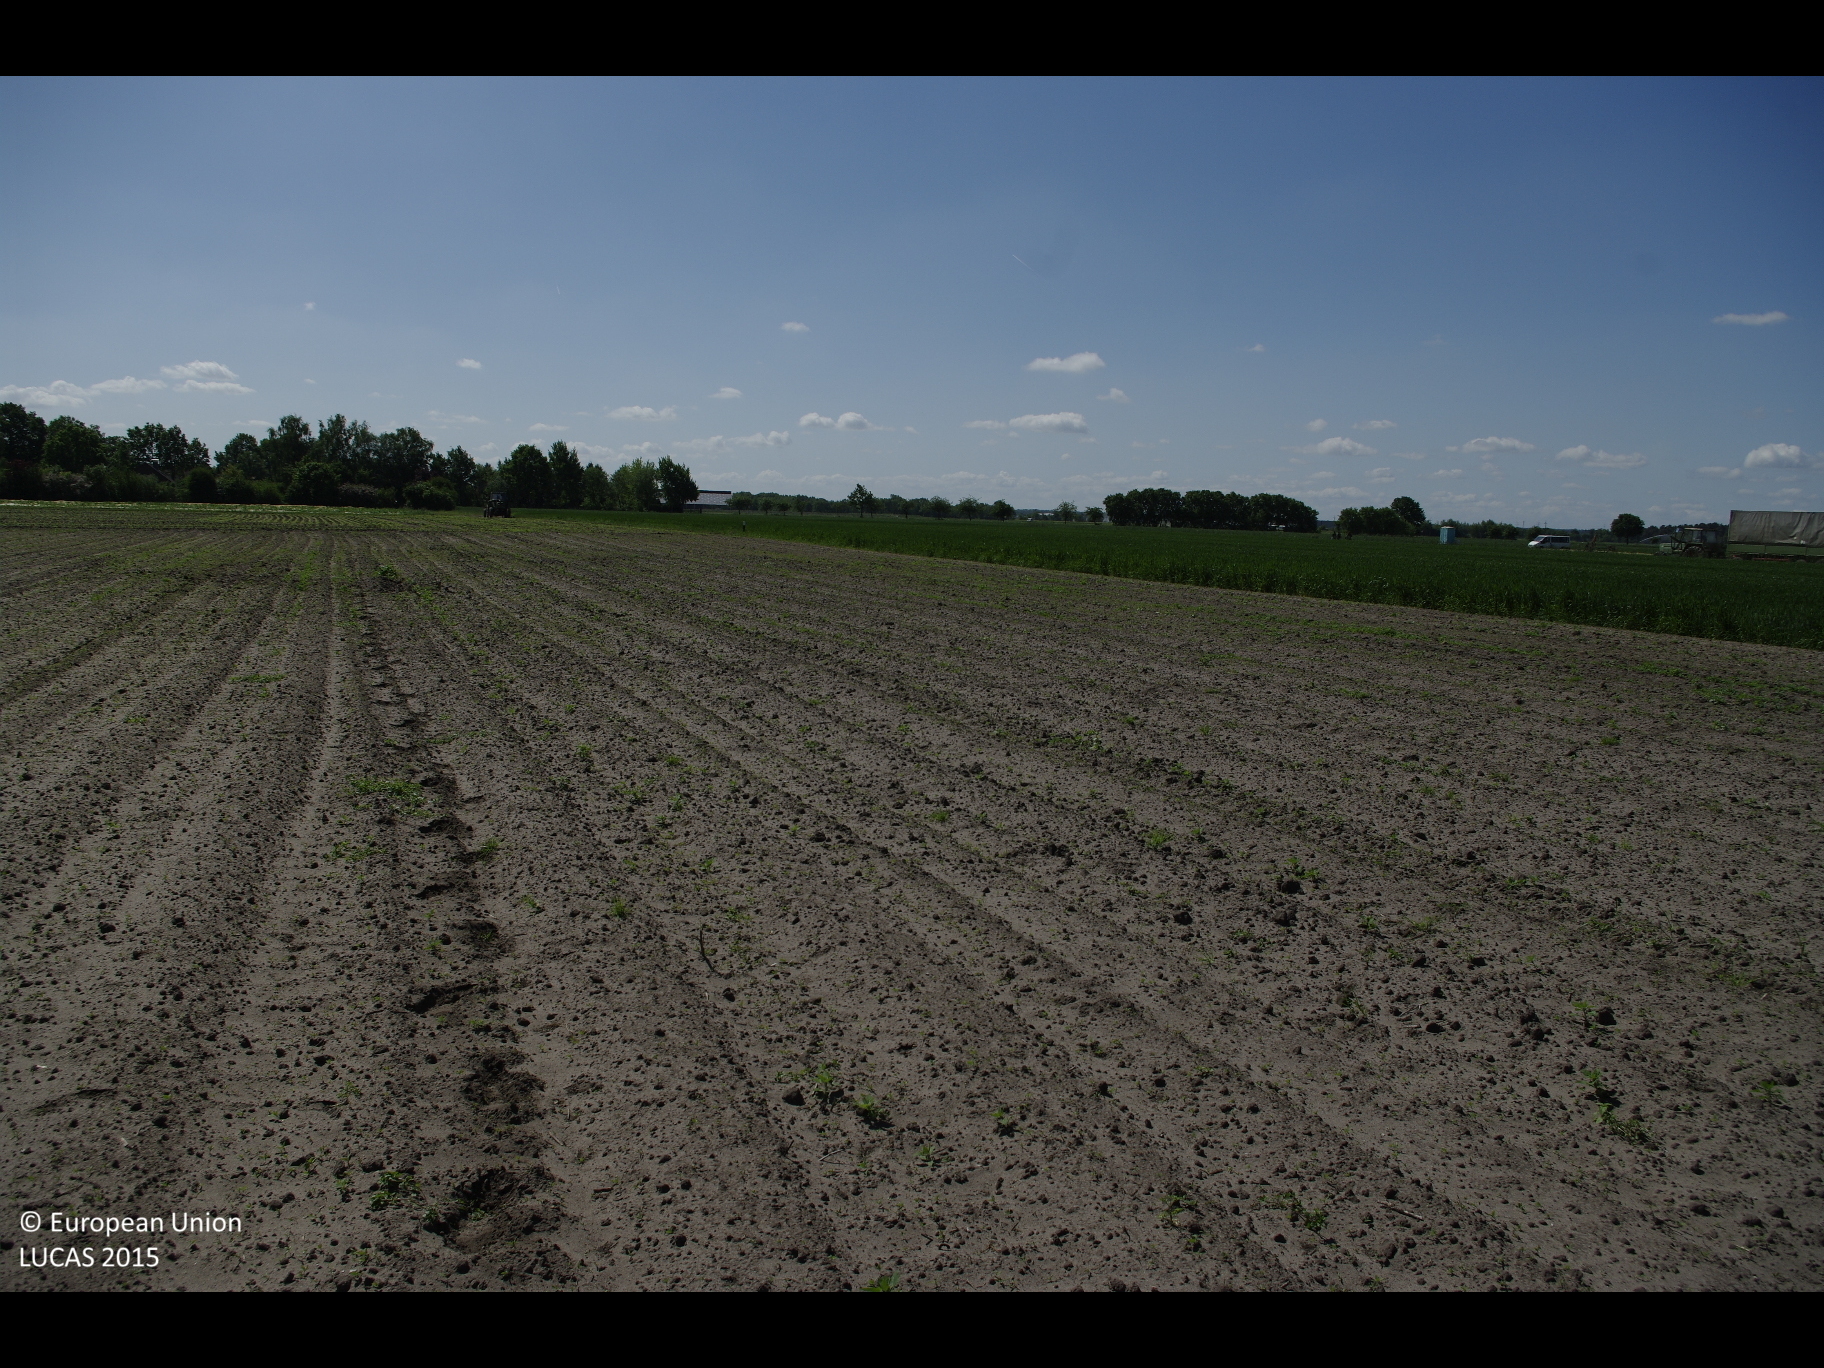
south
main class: Cropland
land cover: Maize
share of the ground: < 10 %
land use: Agriculture (excluding fallow land and kitchen gardens)
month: June
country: DE
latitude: 53.3294
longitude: 10.3752
